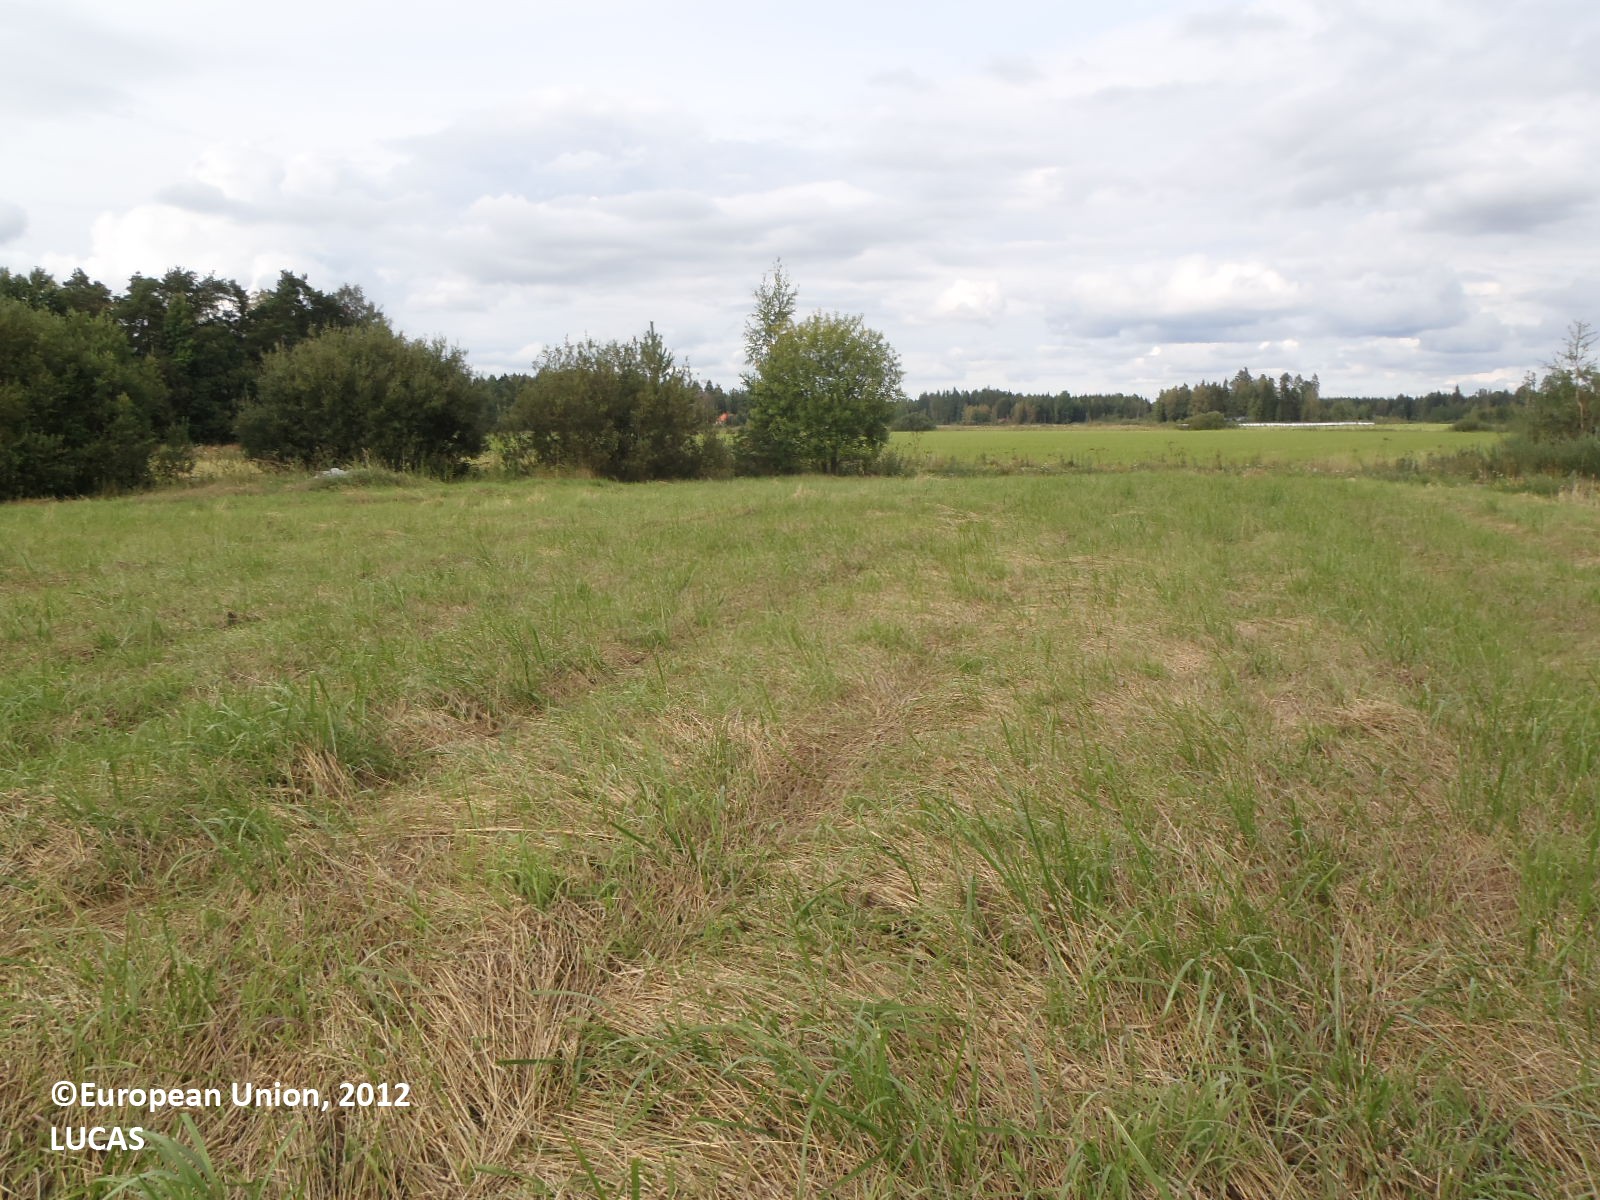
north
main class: Cropland
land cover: Temporary grasslands
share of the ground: > 75 %
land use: Agriculture (excluding fallow land and kitchen gardens)
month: August
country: FI
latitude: 60.6491
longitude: 22.4505
